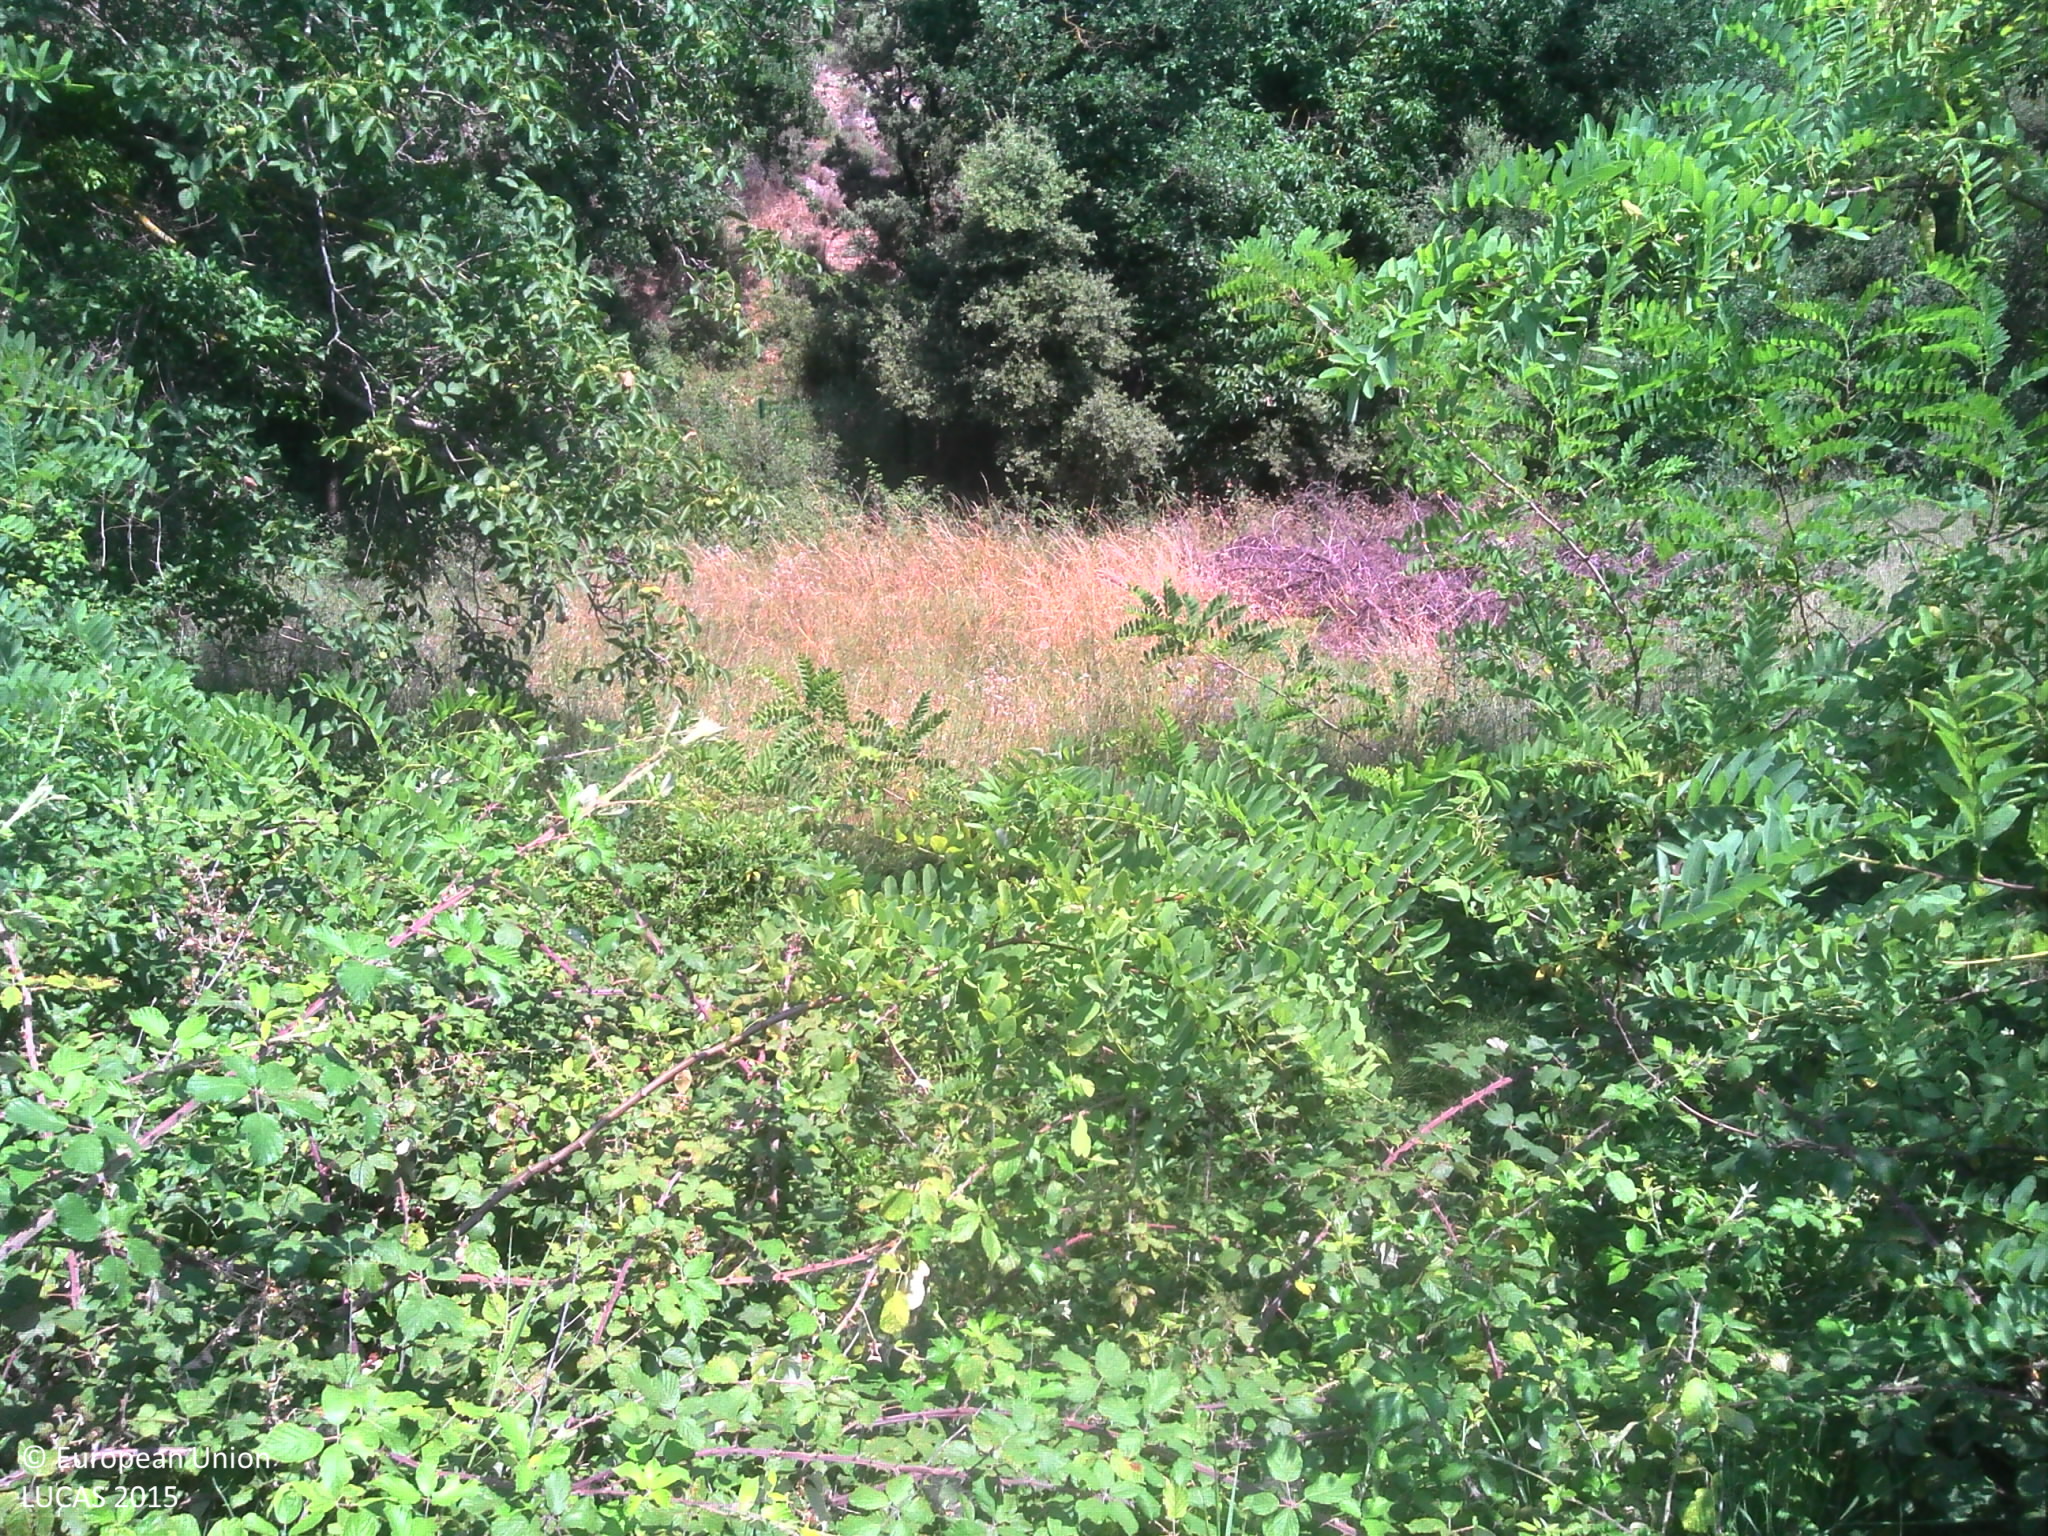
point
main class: Woodland
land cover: Broadleaved woodland
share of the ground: 25 - 50 %
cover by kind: herbaceous plants 50 %, broadleaved forest trees 30 %, shrubs 20 %
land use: Semi-natural and natural areas not in use
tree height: > 5 m
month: July
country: FR
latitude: 43.6978
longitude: 5.2074
